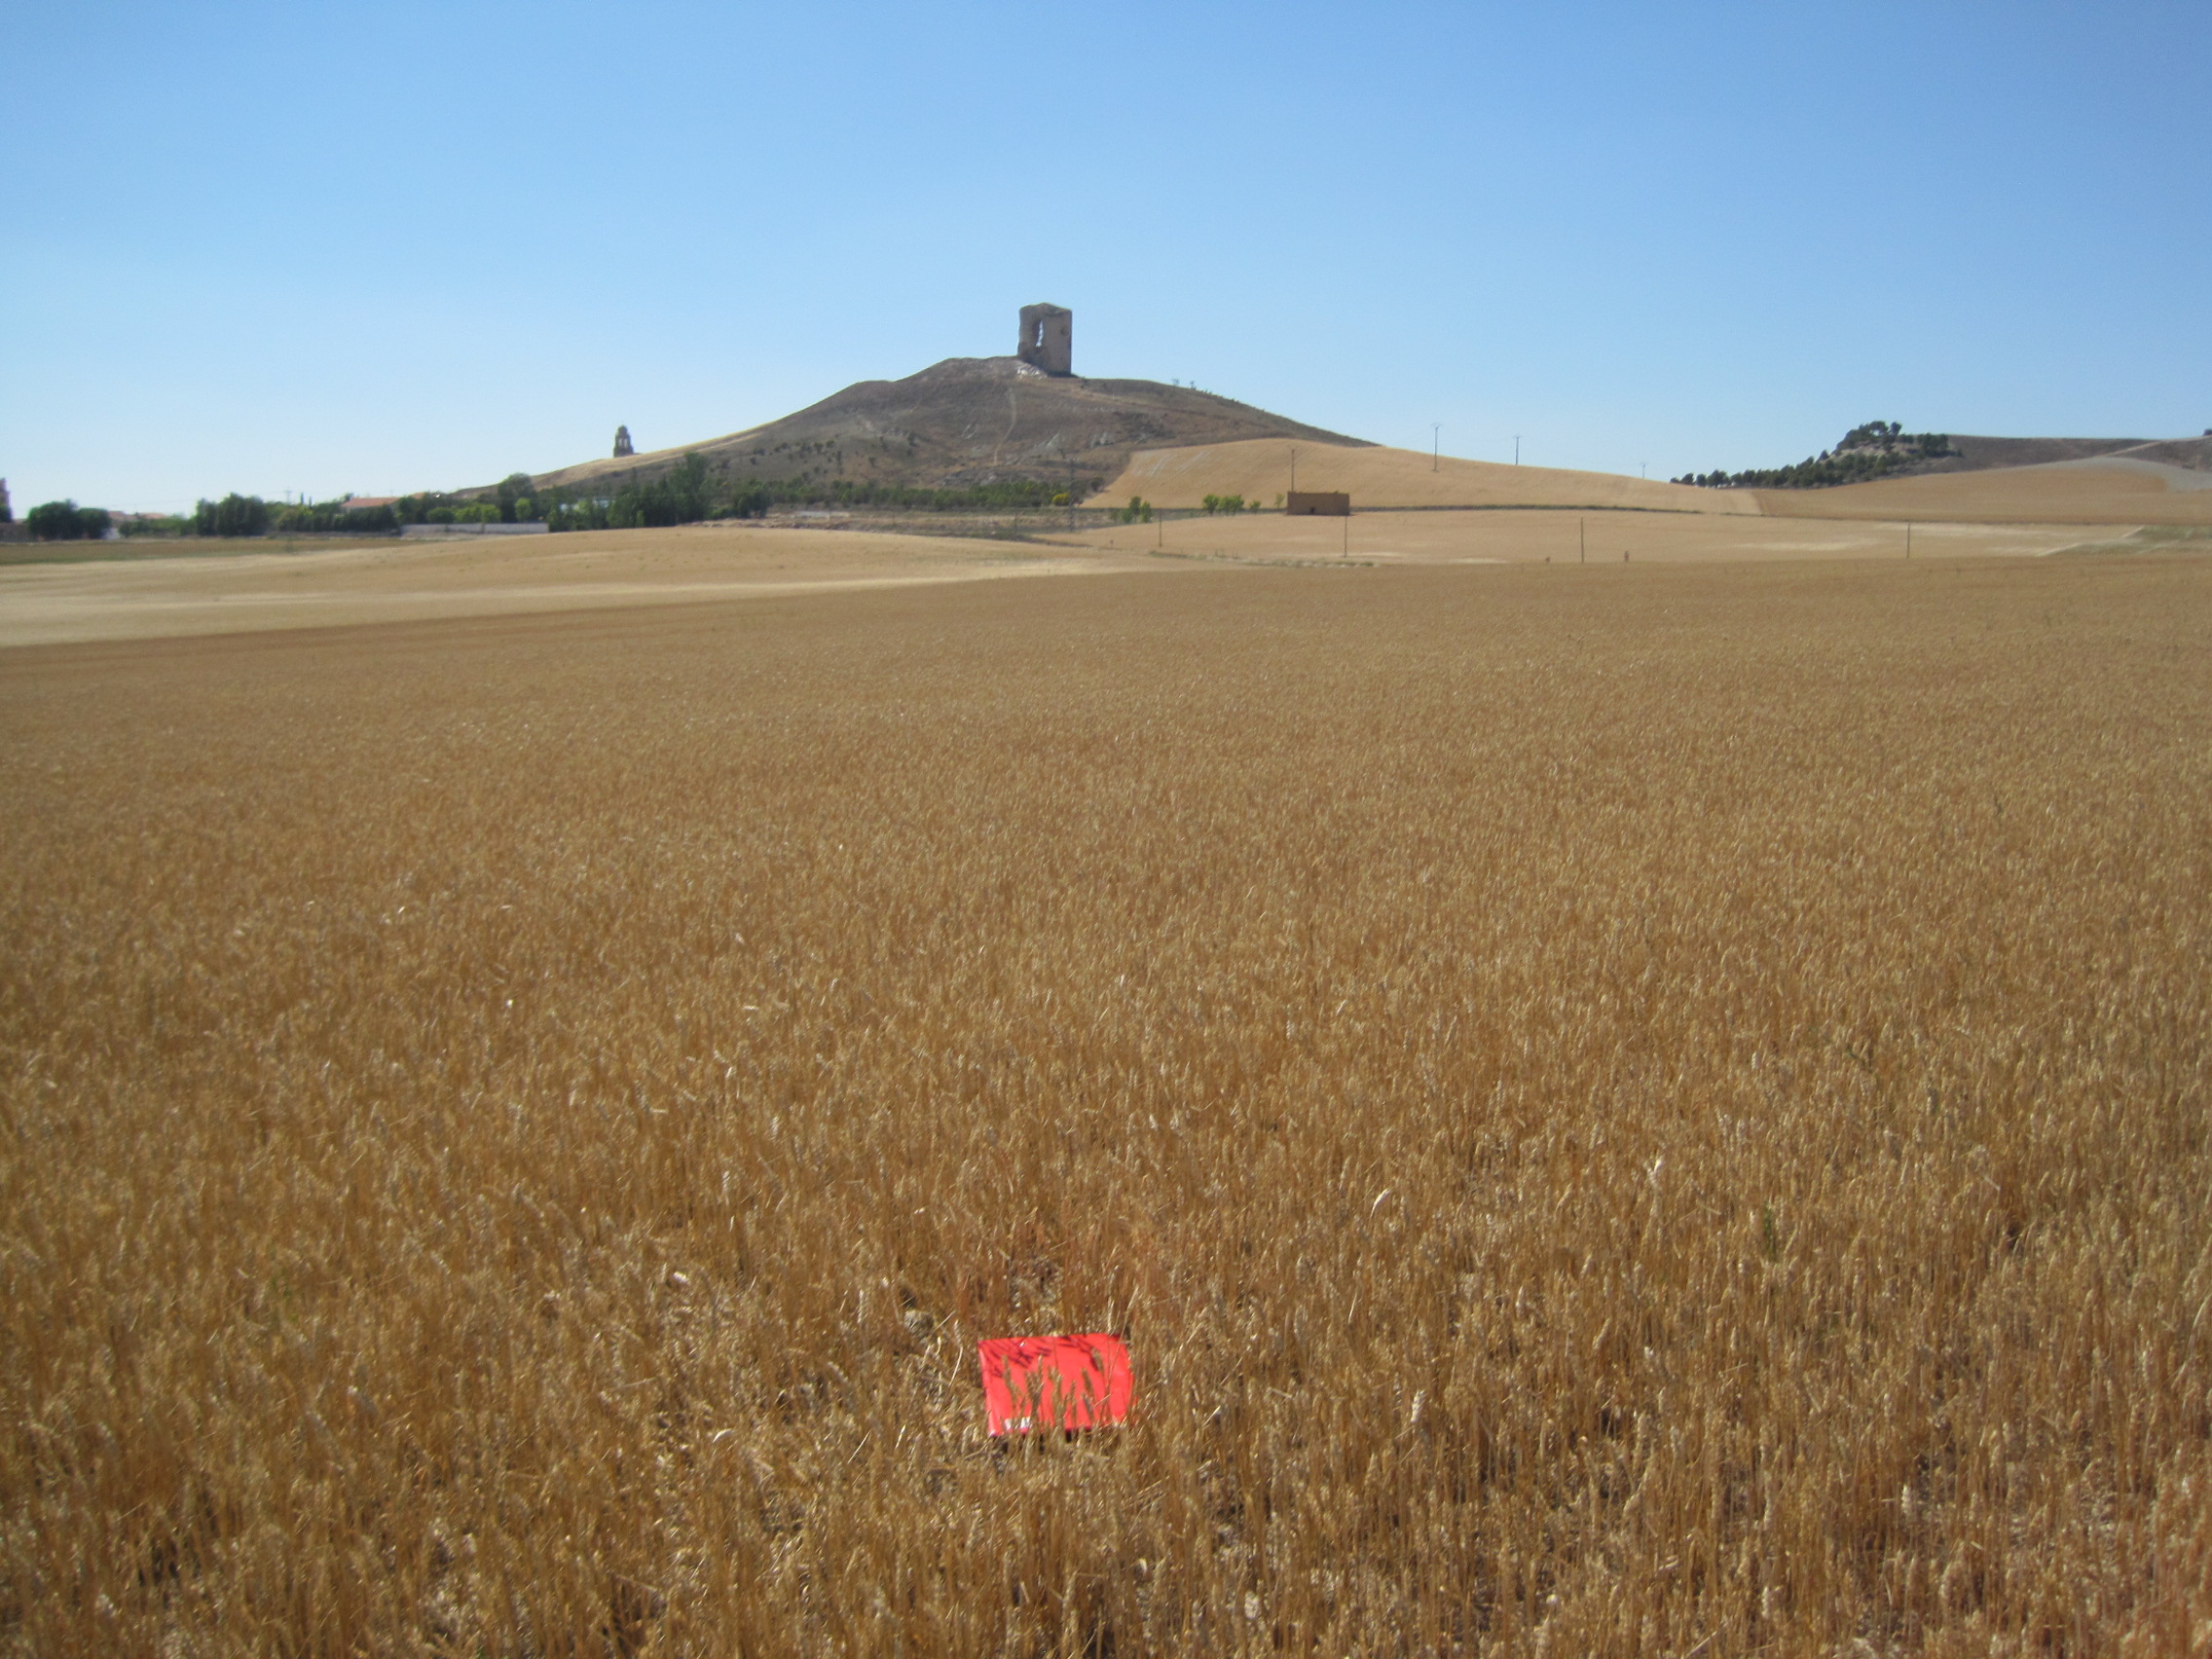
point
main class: Cropland
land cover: Common wheat
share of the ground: > 75 %
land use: Agriculture (excluding fallow land and kitchen gardens)
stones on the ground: 10 - 25 %
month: June
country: ES
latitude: 41.6328
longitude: -5.1659
